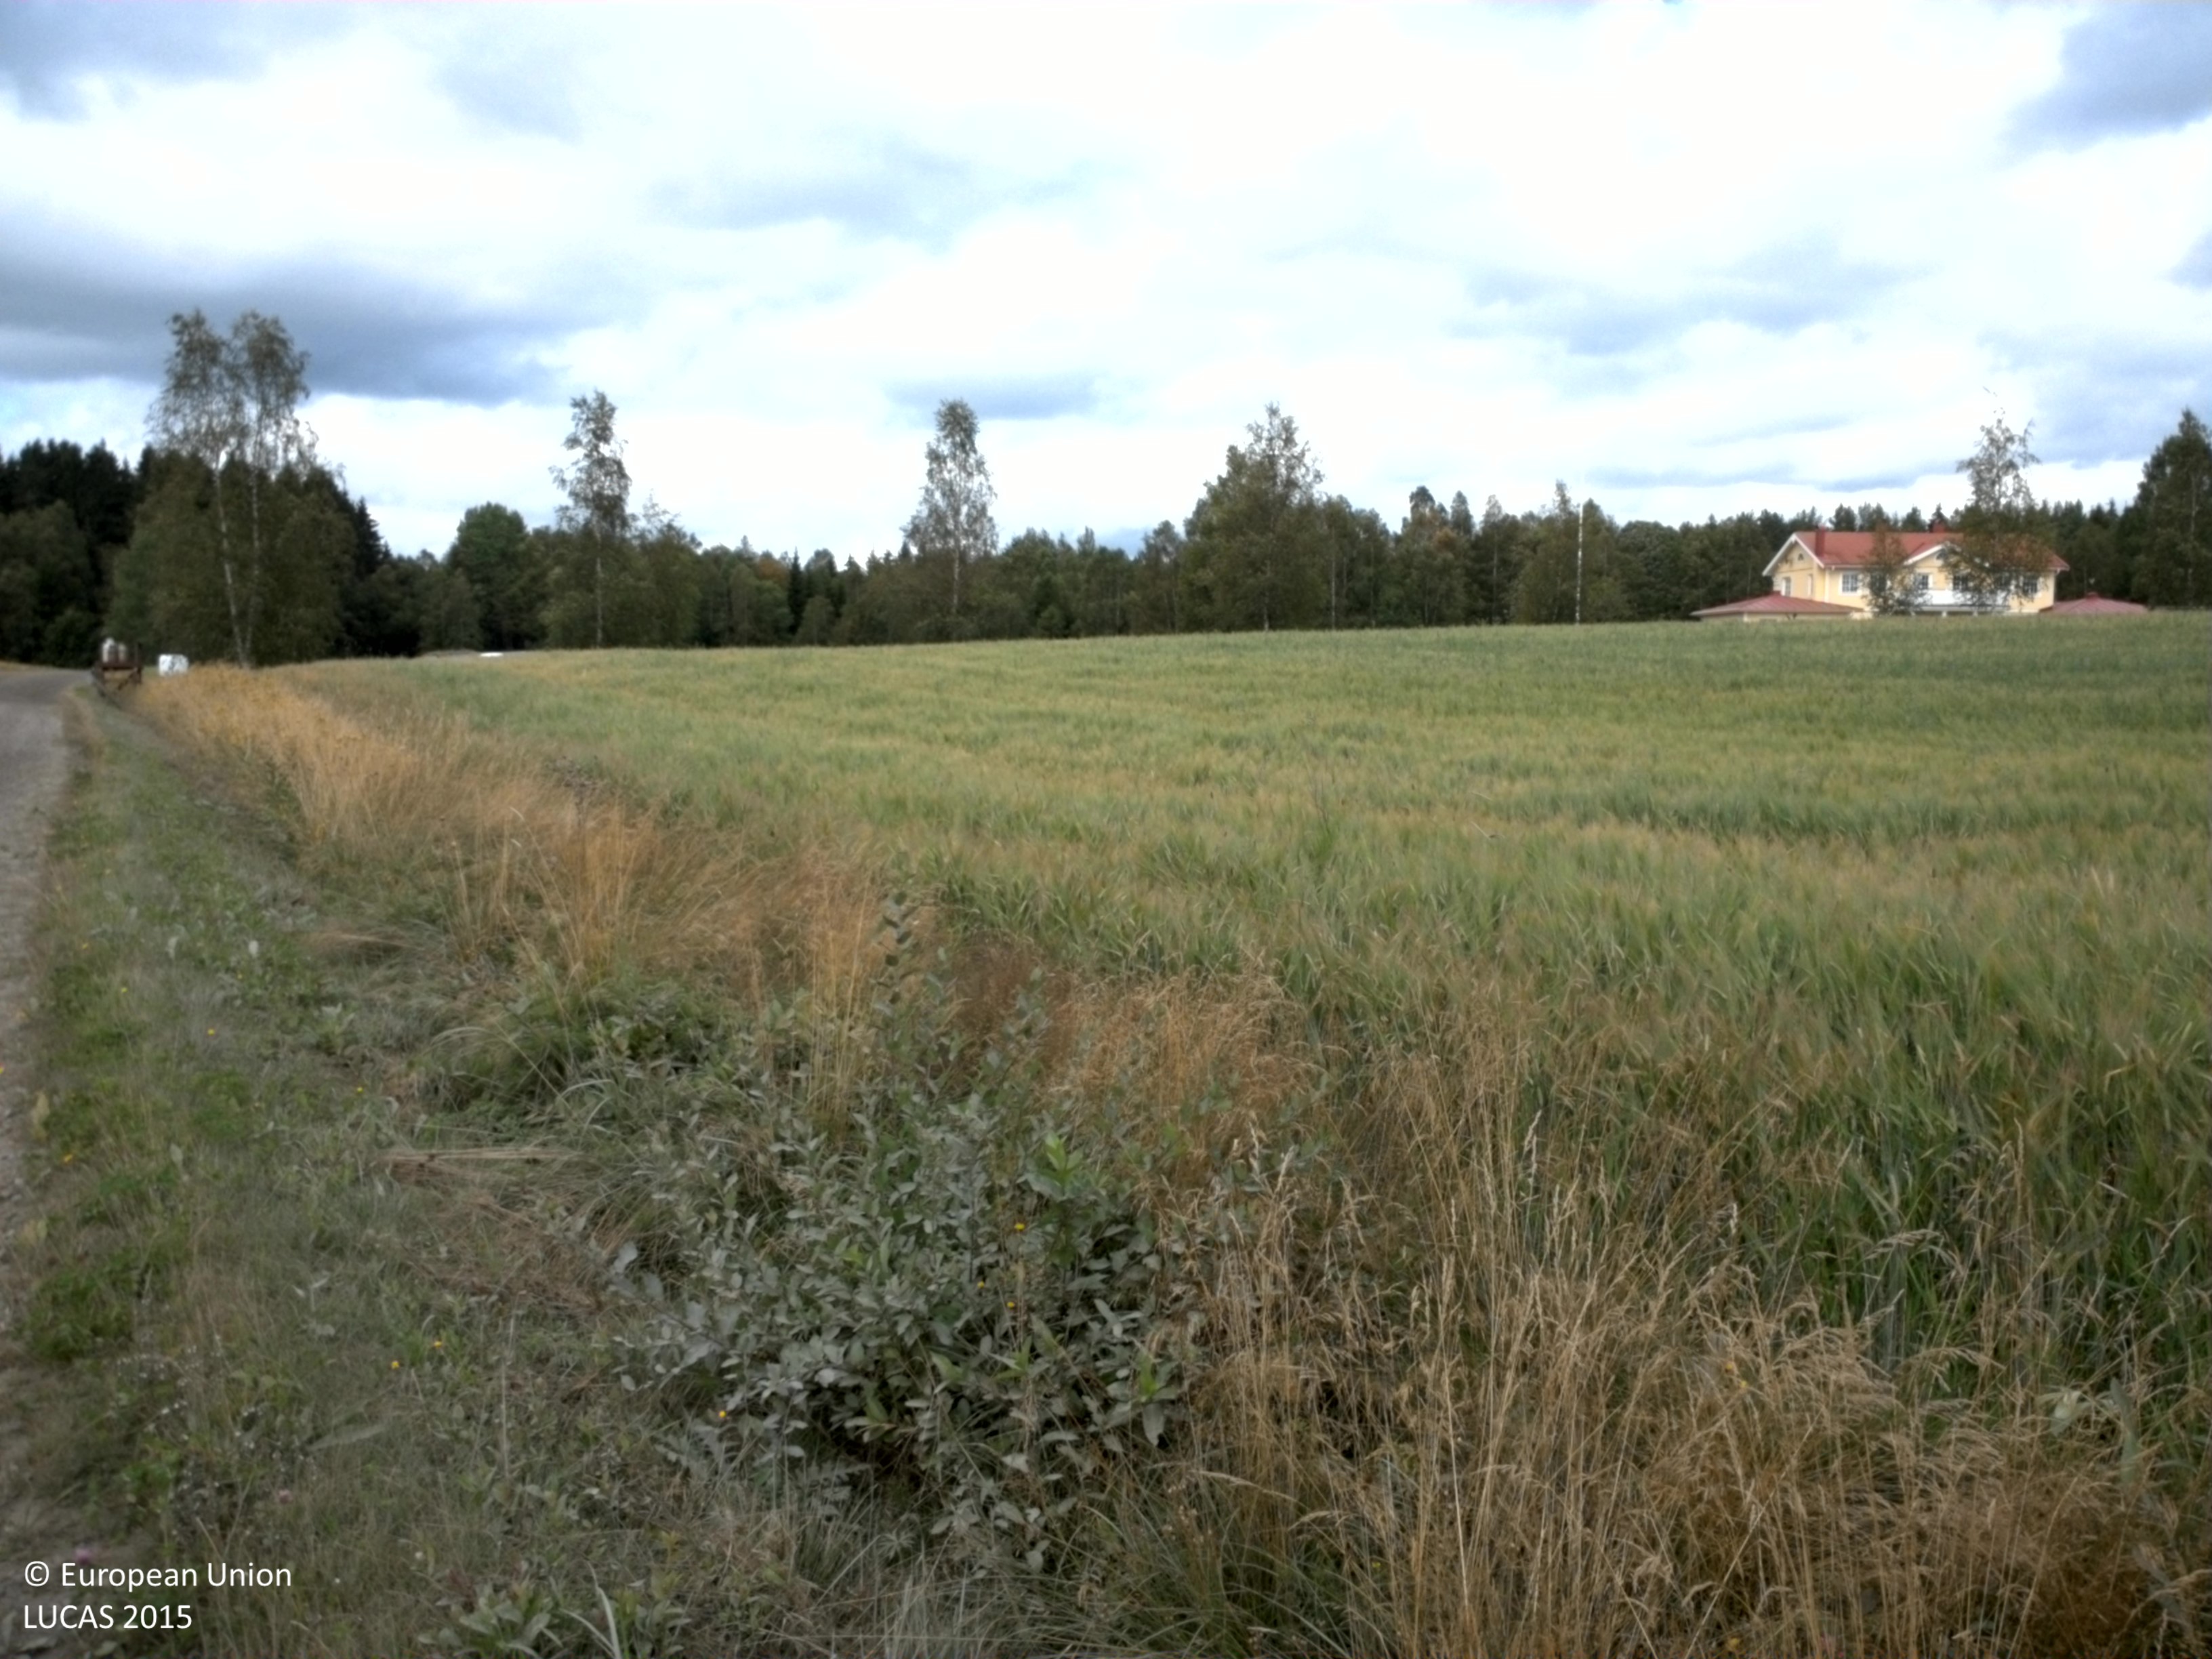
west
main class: Cropland
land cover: Mixed cereals for fodder
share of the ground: > 75 %
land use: Agriculture (excluding fallow land and kitchen gardens)
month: August
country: SE
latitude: 59.4639
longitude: 12.0239
